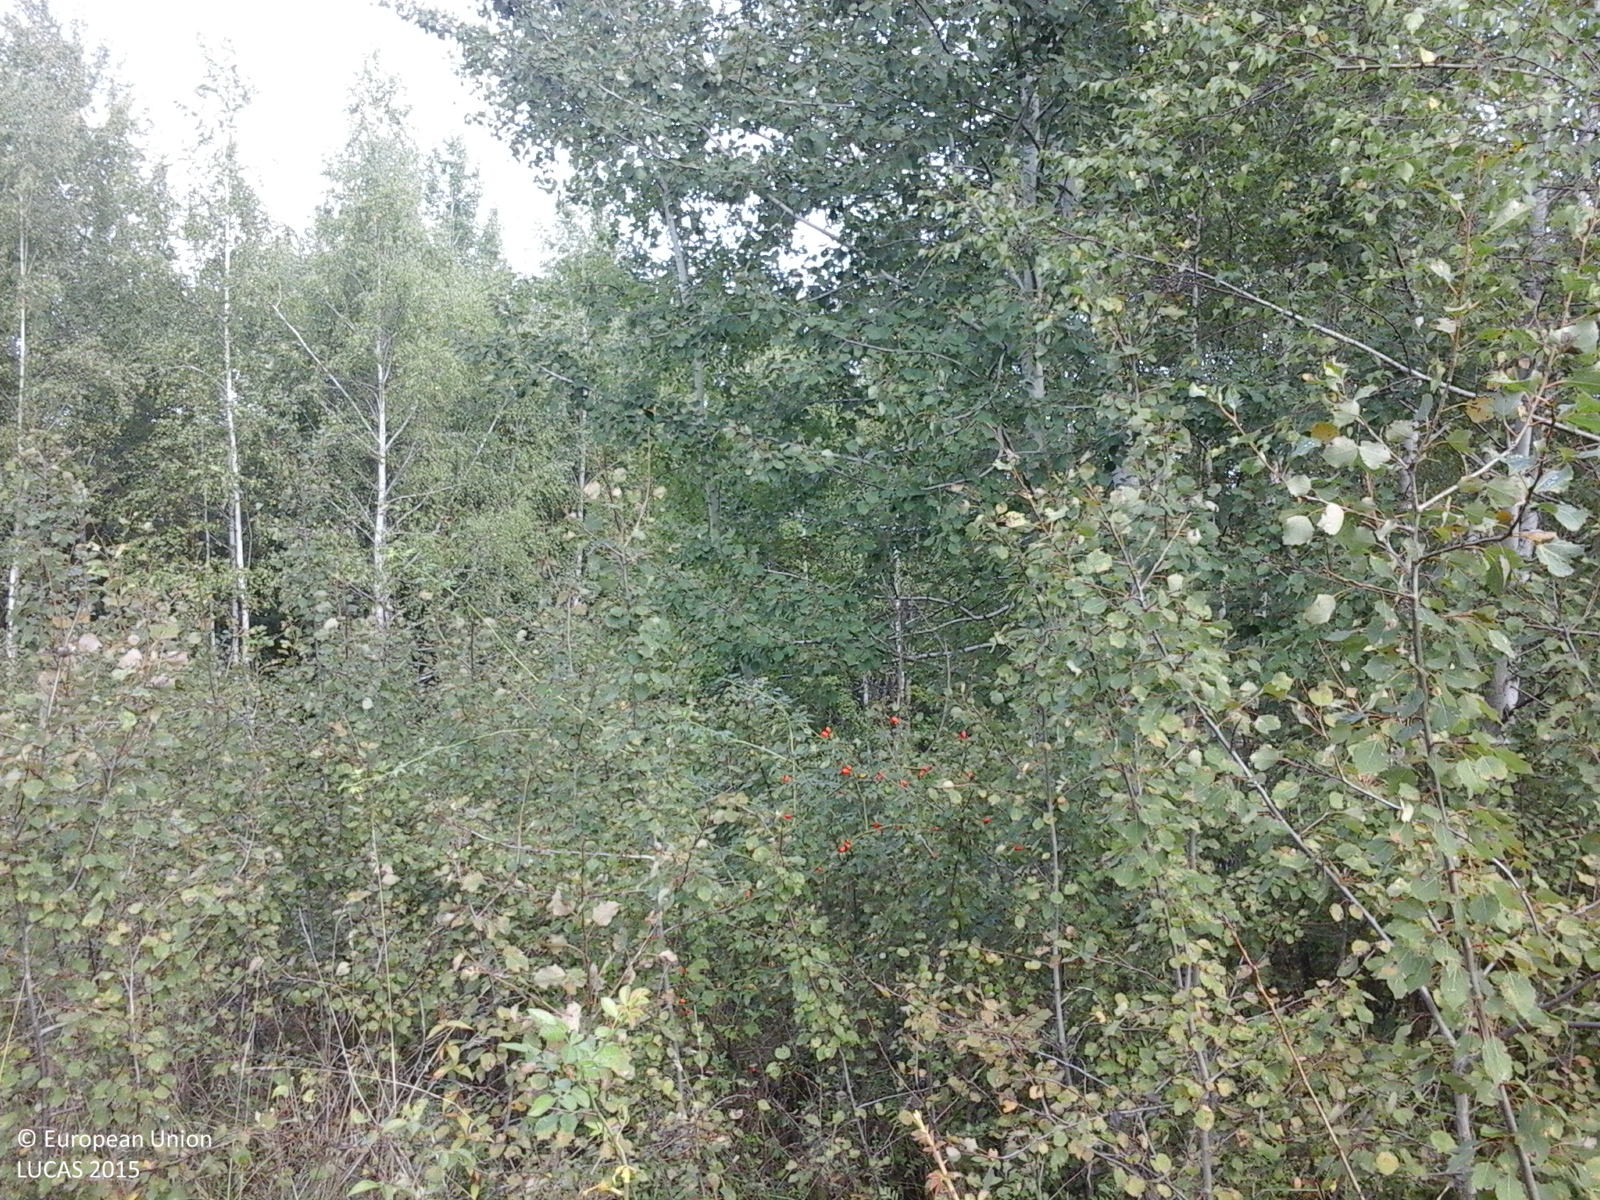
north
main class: Woodland
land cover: Broadleaved woodland
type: non-riverine alder, birch or aspen forest
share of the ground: > 75 %
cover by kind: broadleaved forest trees 100 %
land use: Forestry
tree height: > 5 m
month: September
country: RO
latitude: 45.4671
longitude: 22.0489
